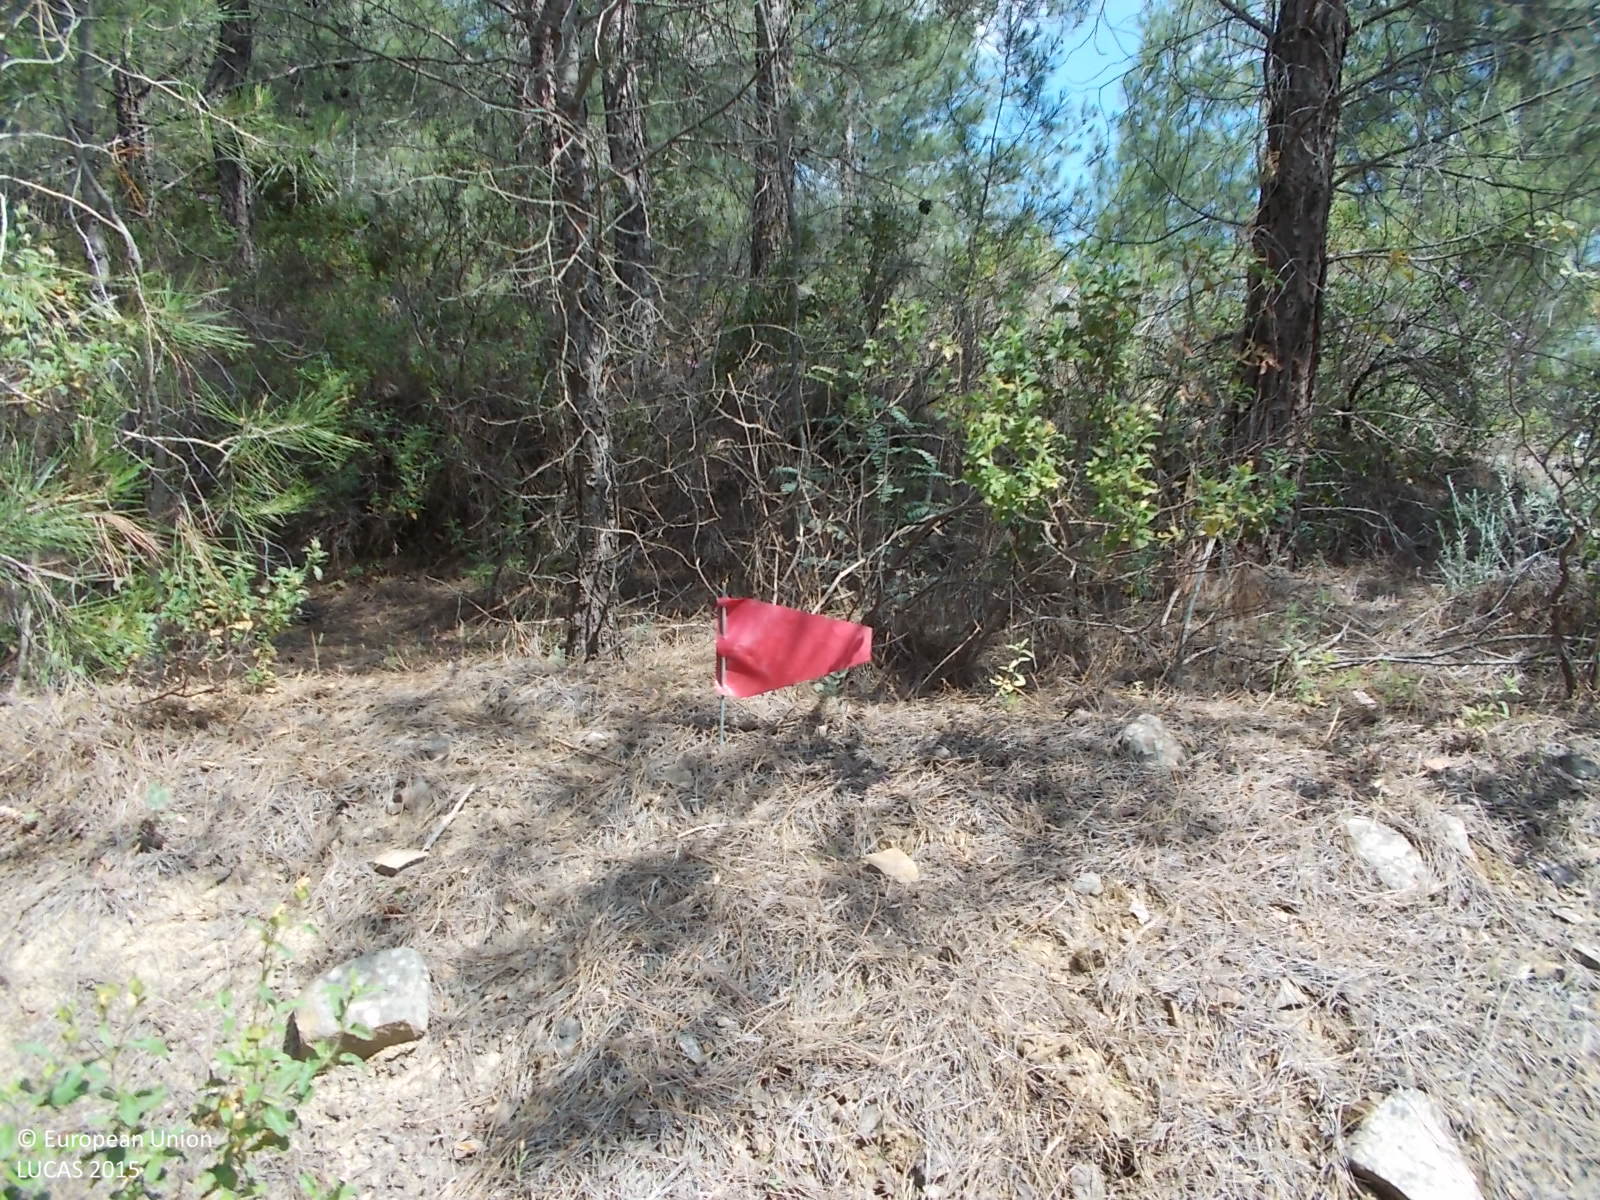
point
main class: Woodland
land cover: Pine dominated coniferous woodland
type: coniferous forest of the mediterranean region
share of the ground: > 75 %
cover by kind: coniferous forest trees 90 %, shrubs 5 %, unconsolidated bare surface 5 %
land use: Semi-natural and natural areas not in use
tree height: > 5 m
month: June
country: CY
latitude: 35.0276
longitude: 32.5954
